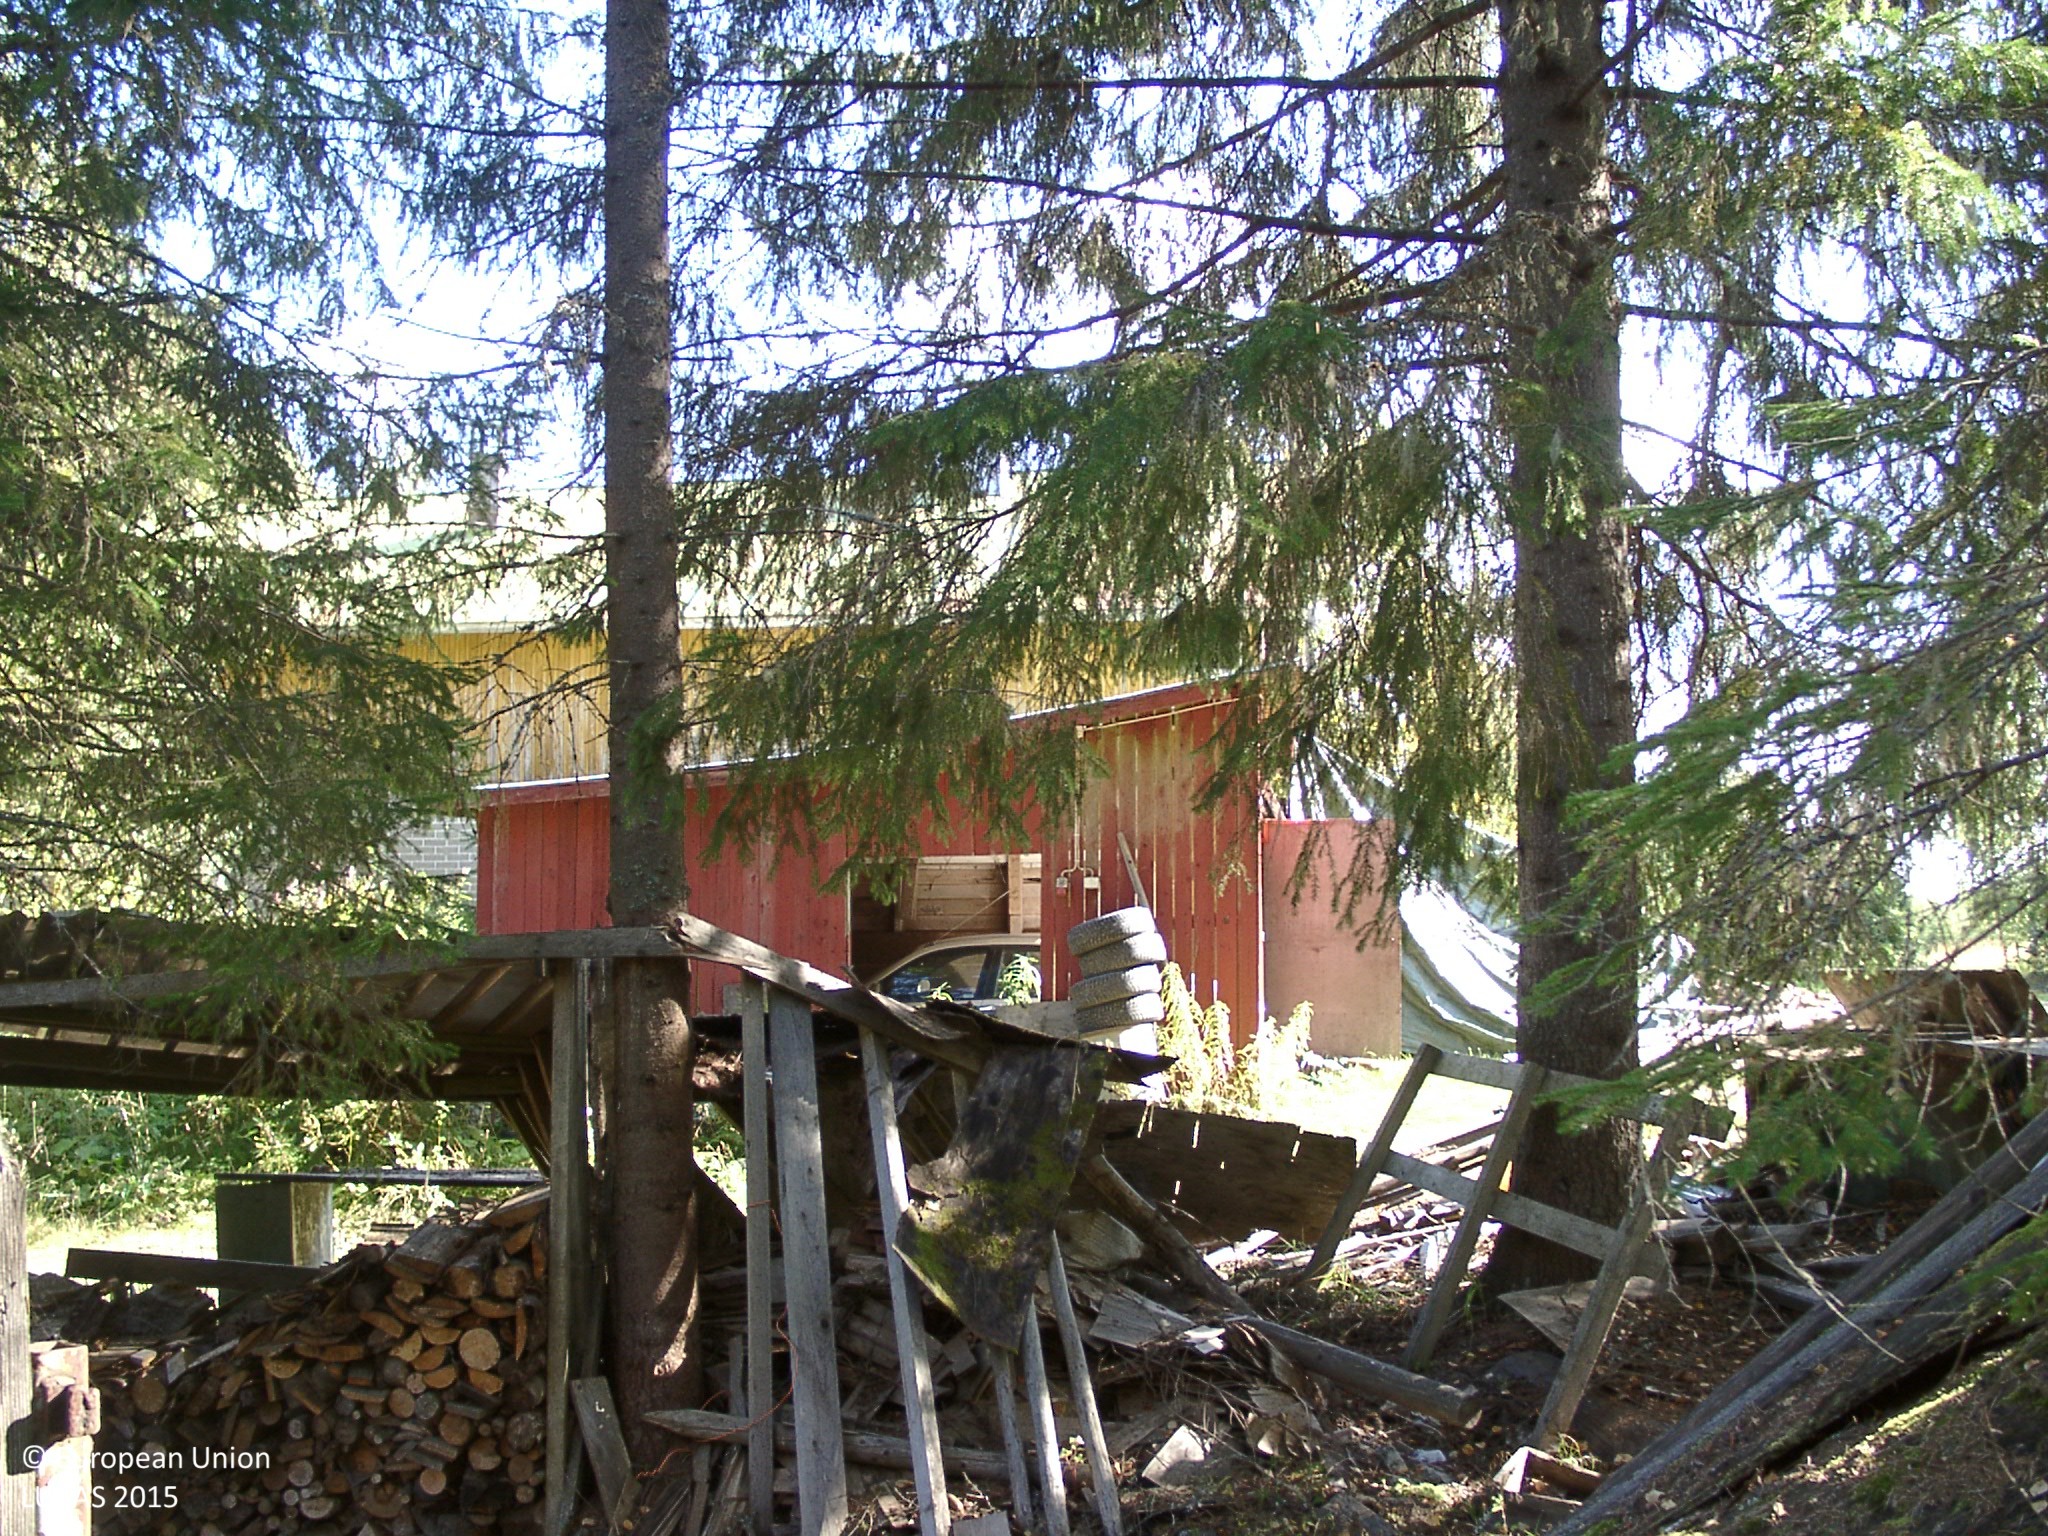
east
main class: Grassland
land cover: Grassland with sparse tree/shrub cover
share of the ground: 50 - 75 %
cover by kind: herbaceous plants 50 %, unconsolidated bare surface 15 %, lichens and mosses 10 %, broadleaved forest trees 5 %
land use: Residential
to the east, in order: Grassland with sparse tree/shrub cover; Spruce dominated coniferous woodland; Artificial constructions in urban areas; Grassland without tree/shrub cover; Broadleaved woodland; Spruce dominated coniferous woodland; Spruce dominated mixed woodland; Spruce dominated coniferous woodland; Broadleaved woodland; Ditches and canals; Broadleaved woodland
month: September
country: FI
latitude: 62.4692
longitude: 25.6491
